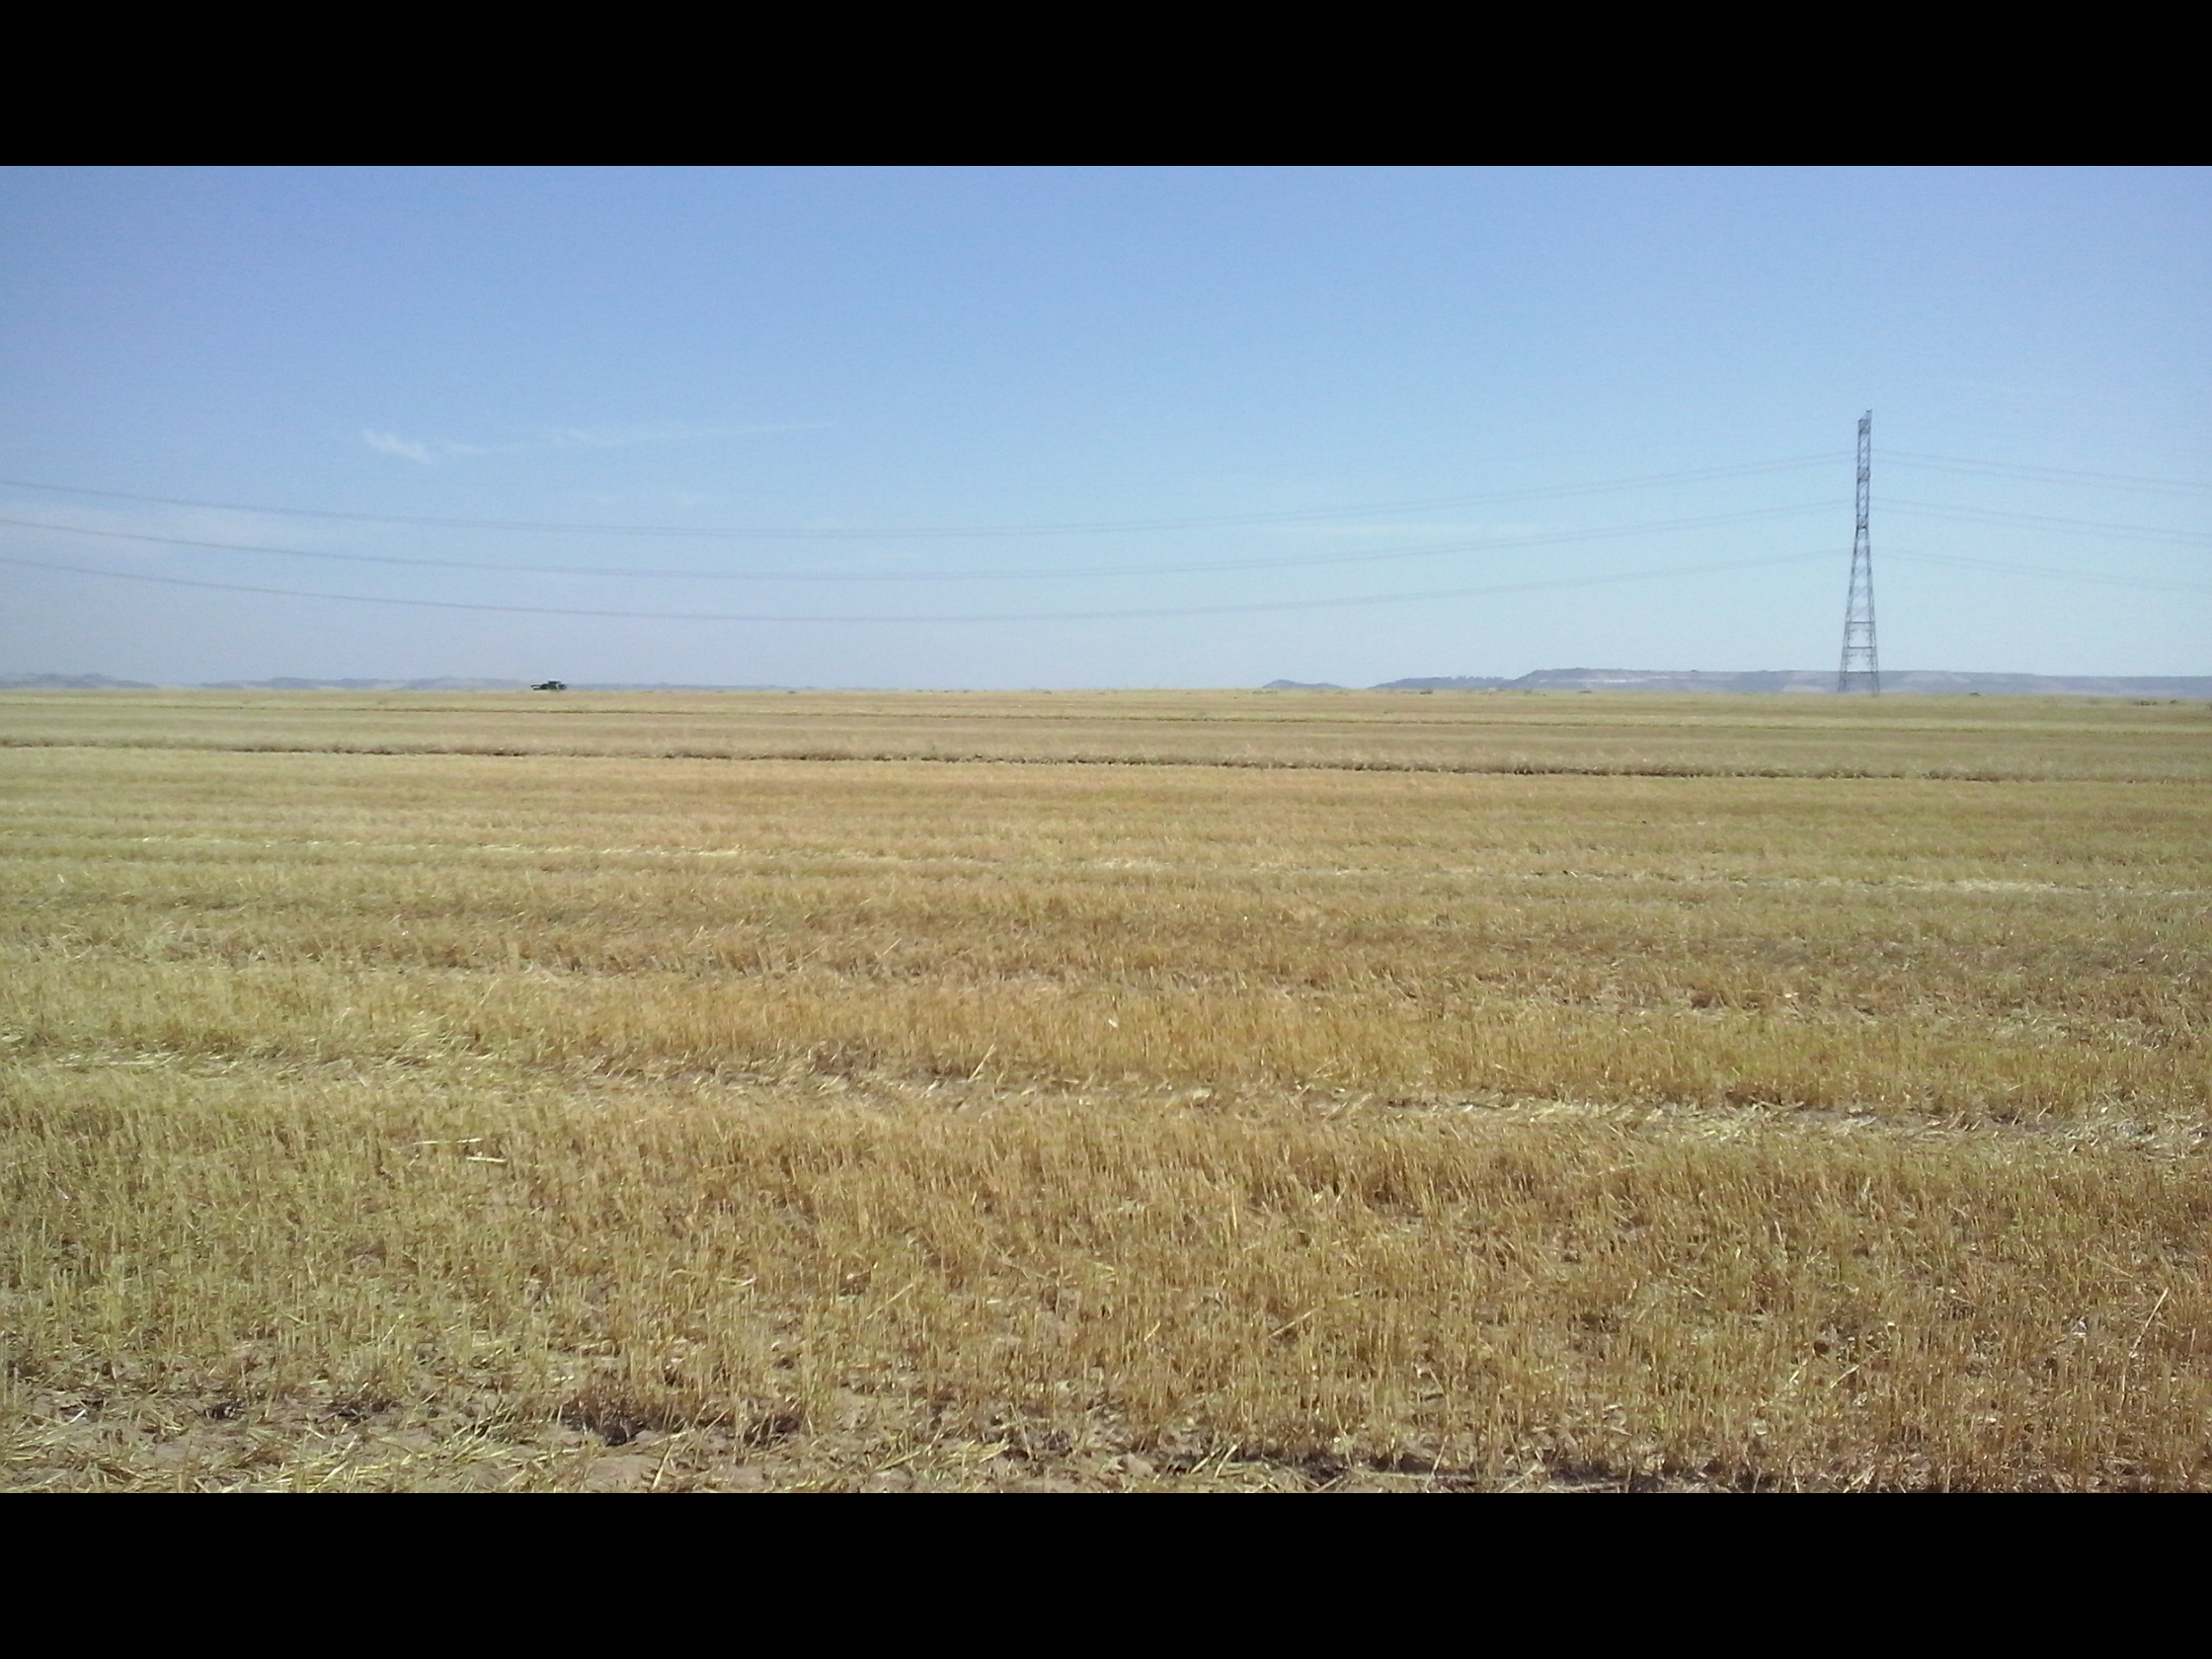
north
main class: Cropland
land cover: Barley
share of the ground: < 10 %
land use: Agriculture (excluding fallow land and kitchen gardens)
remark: Harvested field
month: July
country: ES
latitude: 41.5304
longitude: -5.1158
